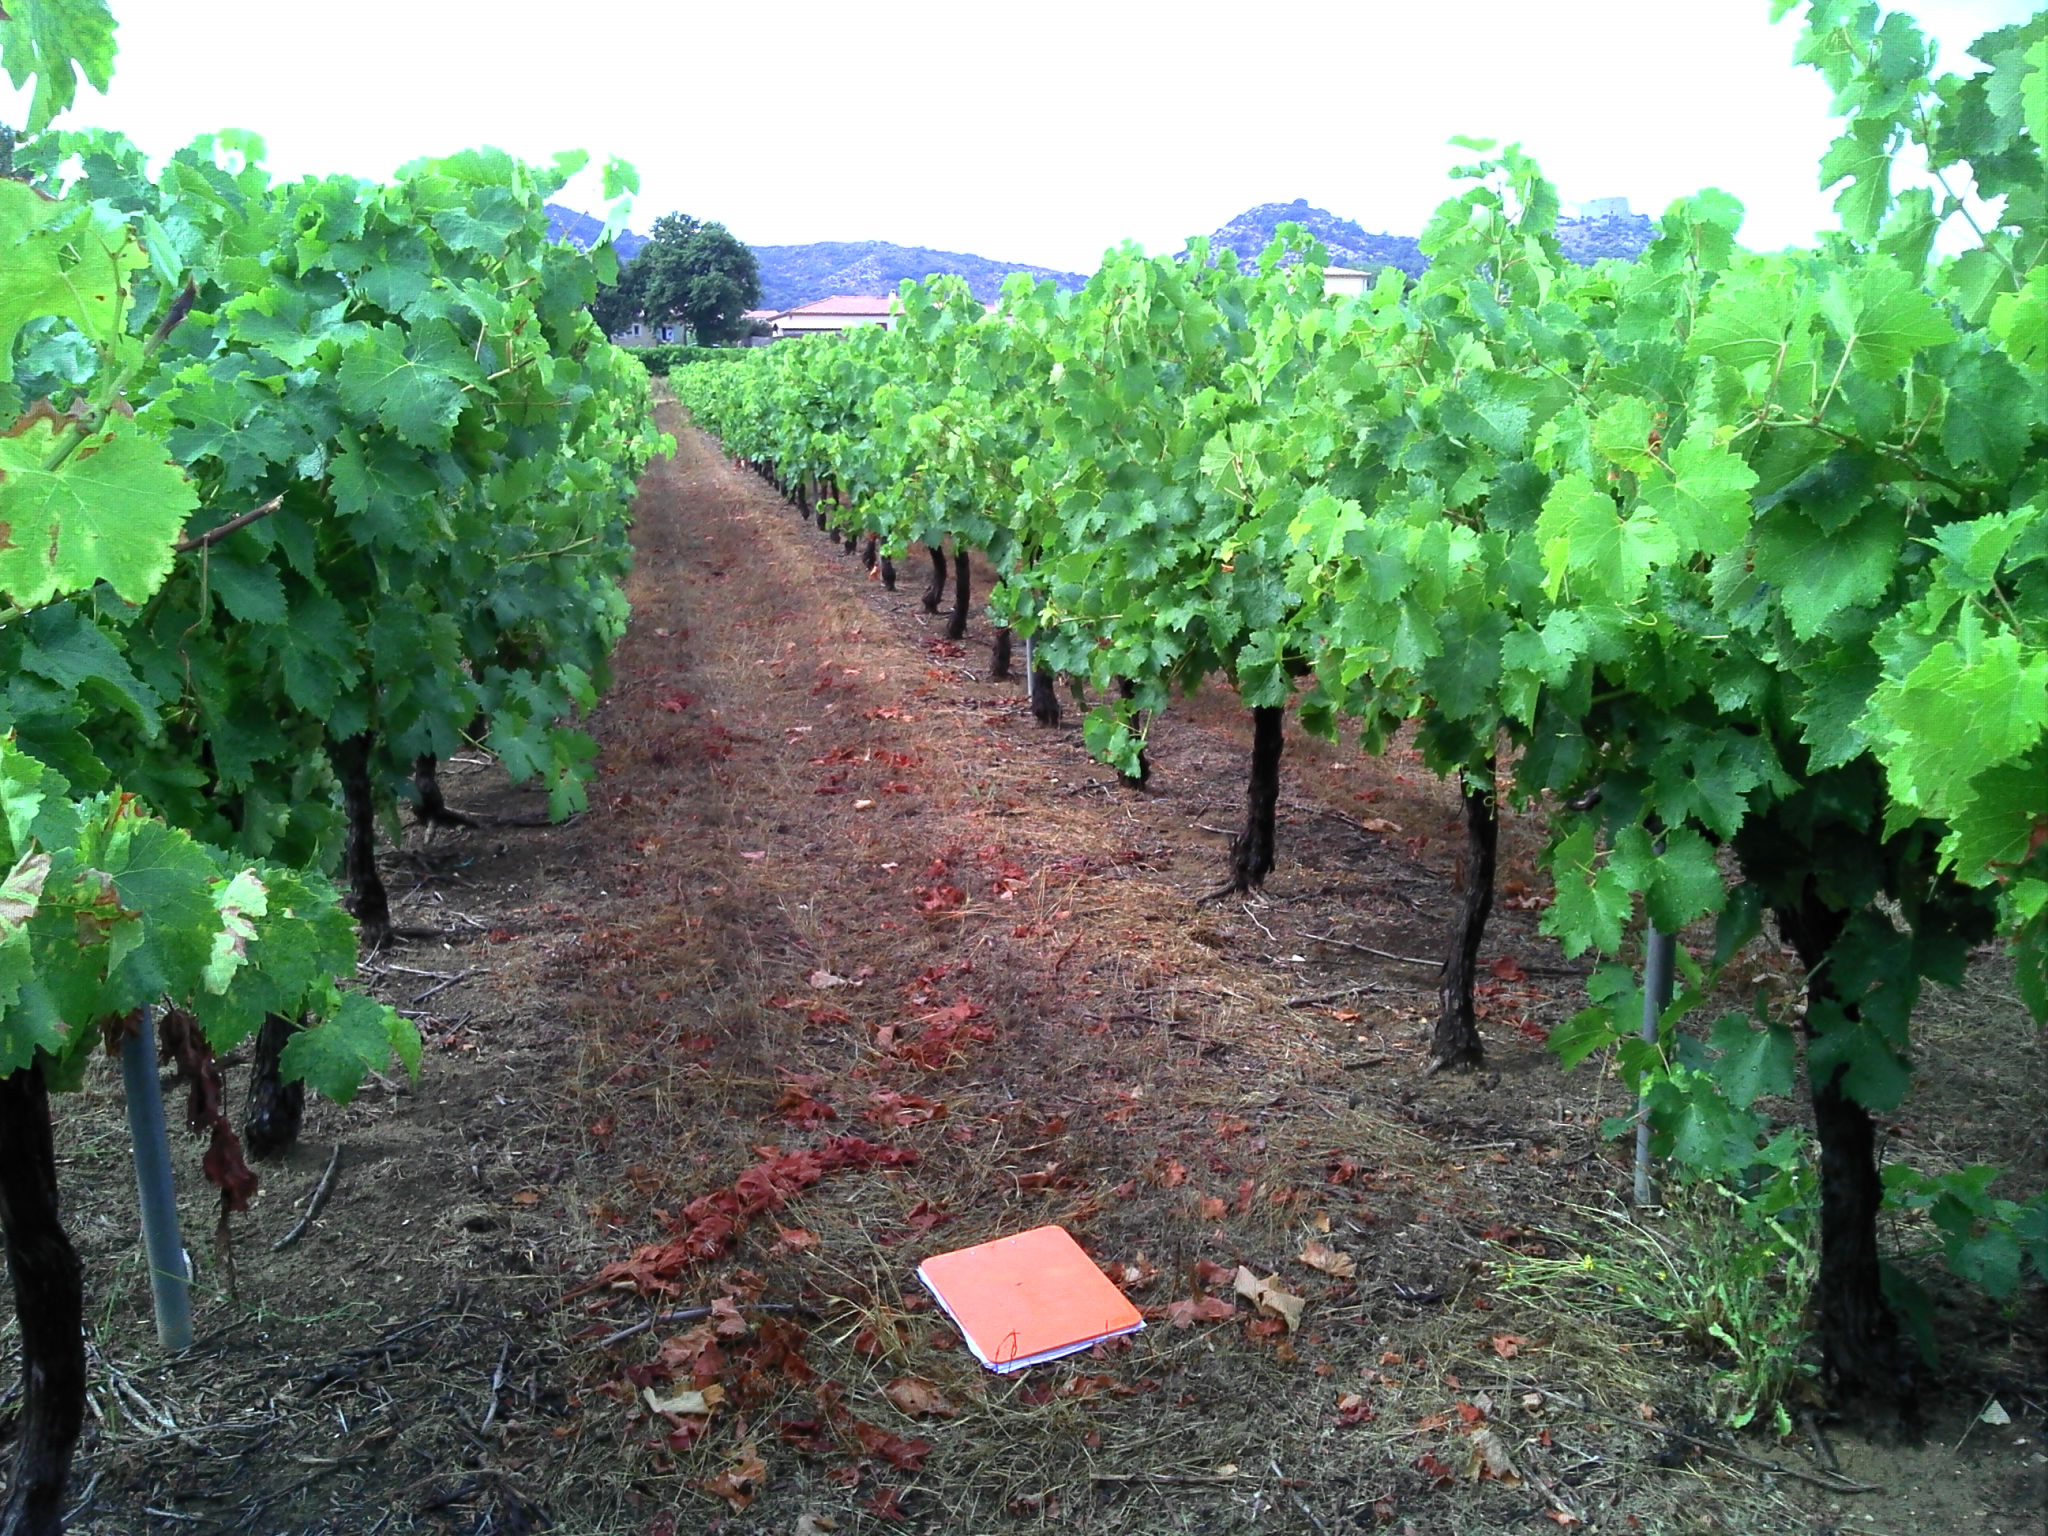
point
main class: Cropland
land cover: Vineyards
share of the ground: 25 - 50 %
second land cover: Spontaneously vegetated surfaces
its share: 50 - 75 %
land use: Agriculture (excluding fallow land and kitchen gardens)
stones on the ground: < 10 %
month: August
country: FR
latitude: 44.0681
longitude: 4.6520
